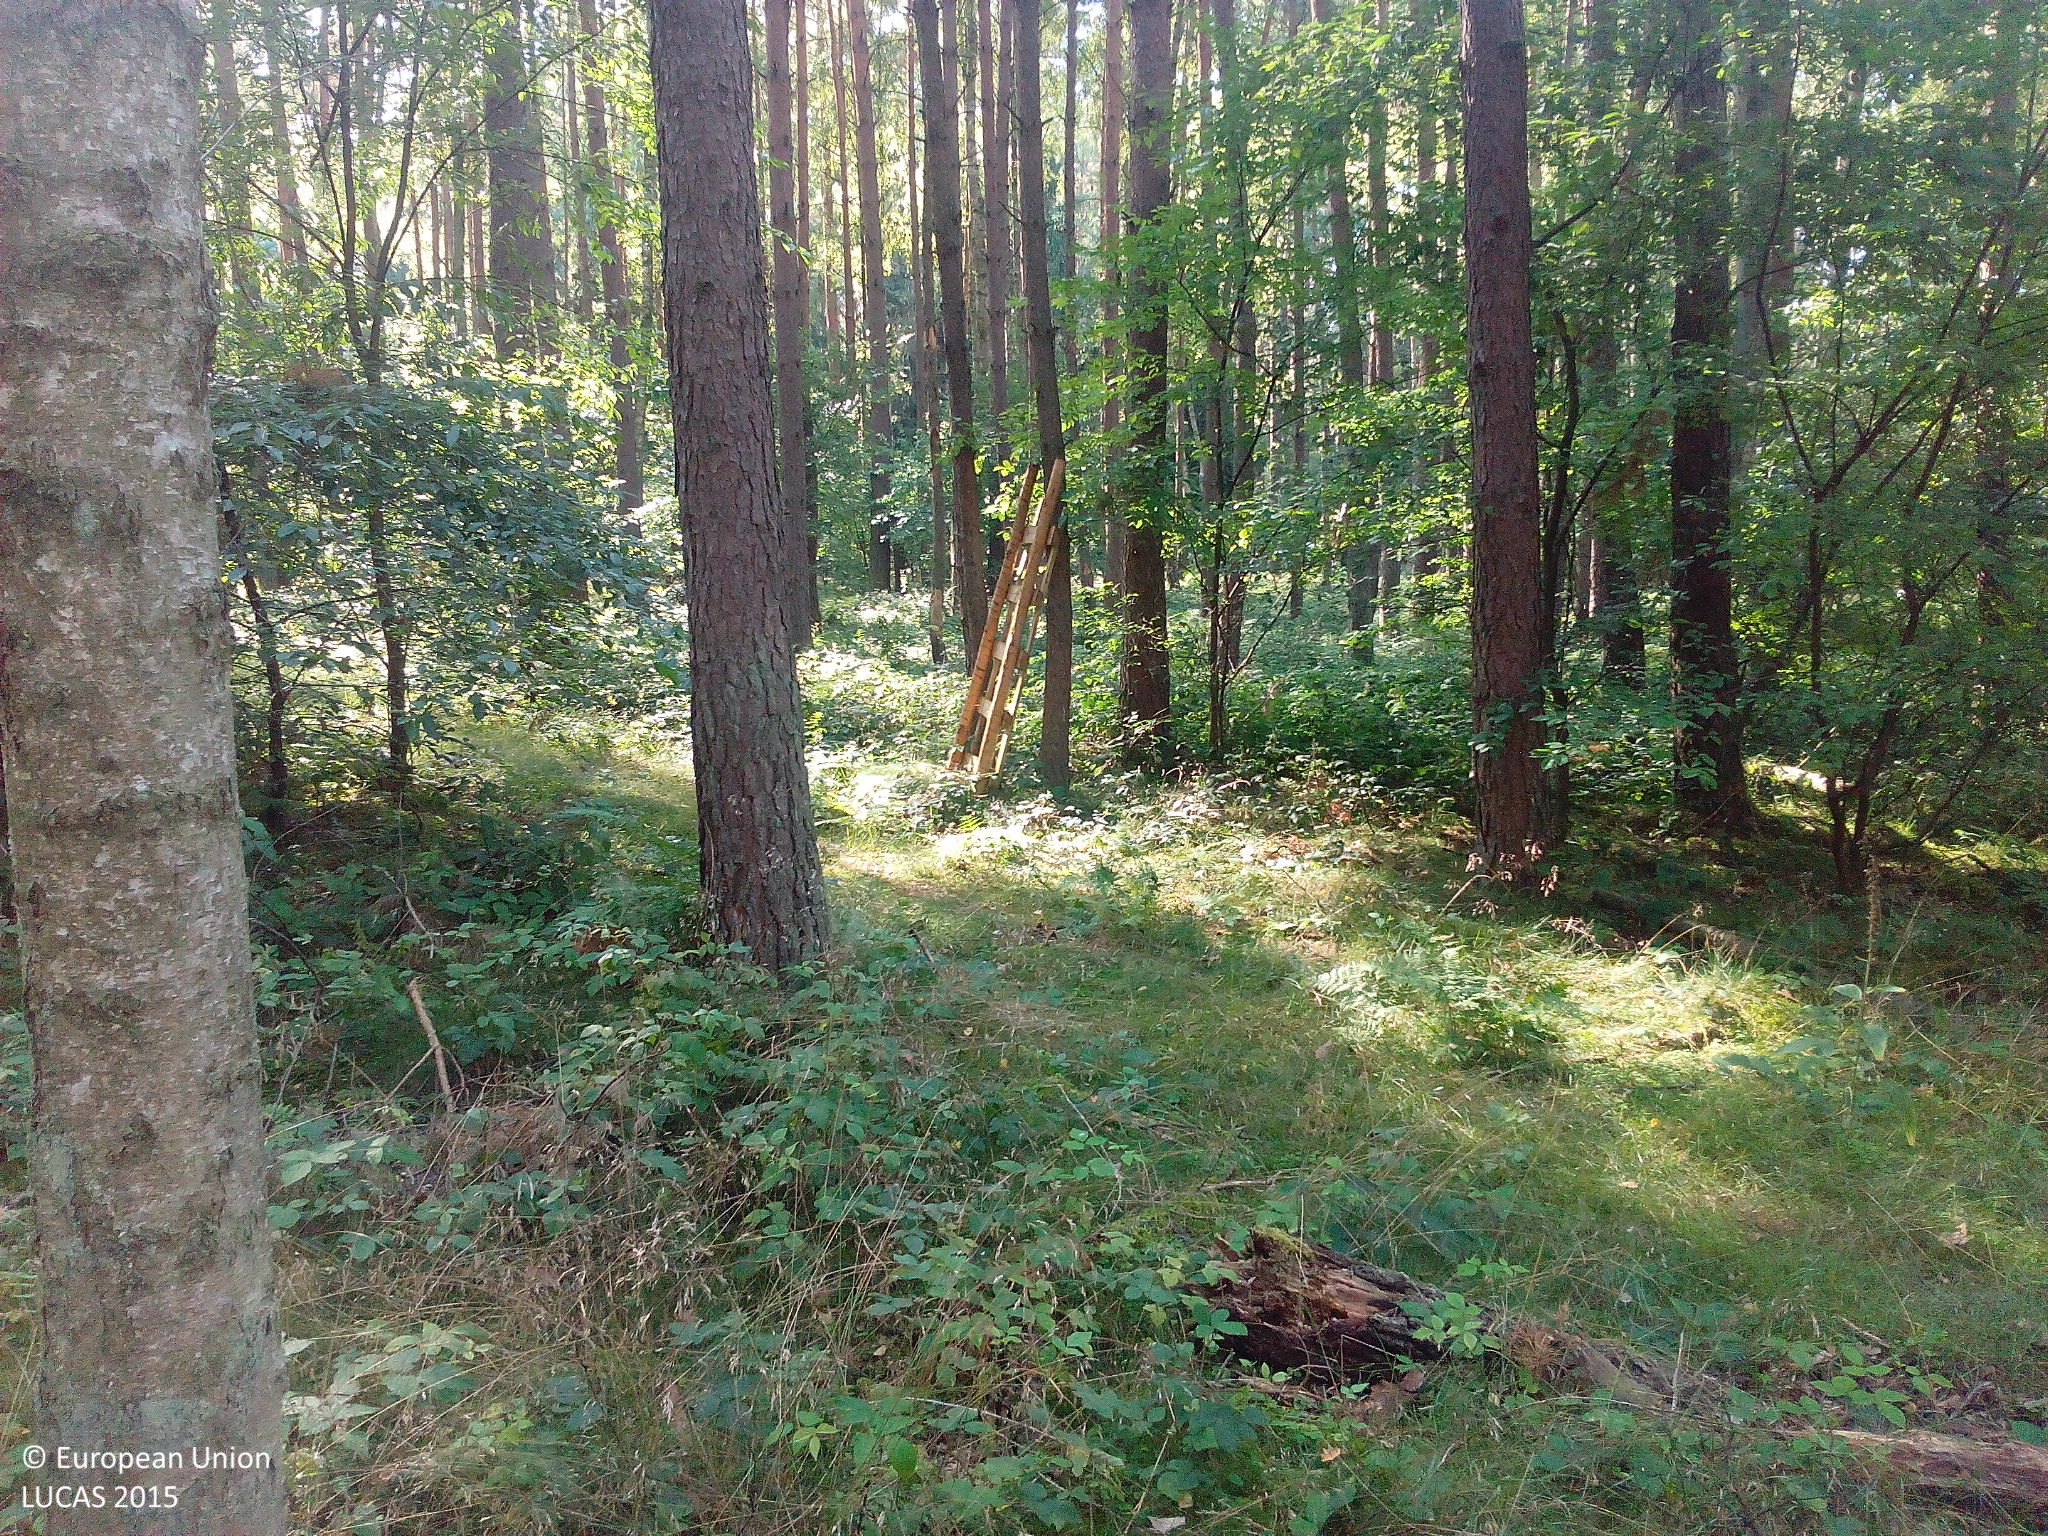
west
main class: Woodland
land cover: Pine dominated mixed woodland
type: hemiboreal forest and nemoral coniferous forest and mixed broadleaved-coniferous forest
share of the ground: > 75 %
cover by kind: coniferous forest trees 60 %, broadleaved forest trees 25 %, herbaceous plants 10 %, shrubs 5 %
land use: Forestry
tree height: > 5 m
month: August
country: DE
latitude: 53.5945
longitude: 12.3714
